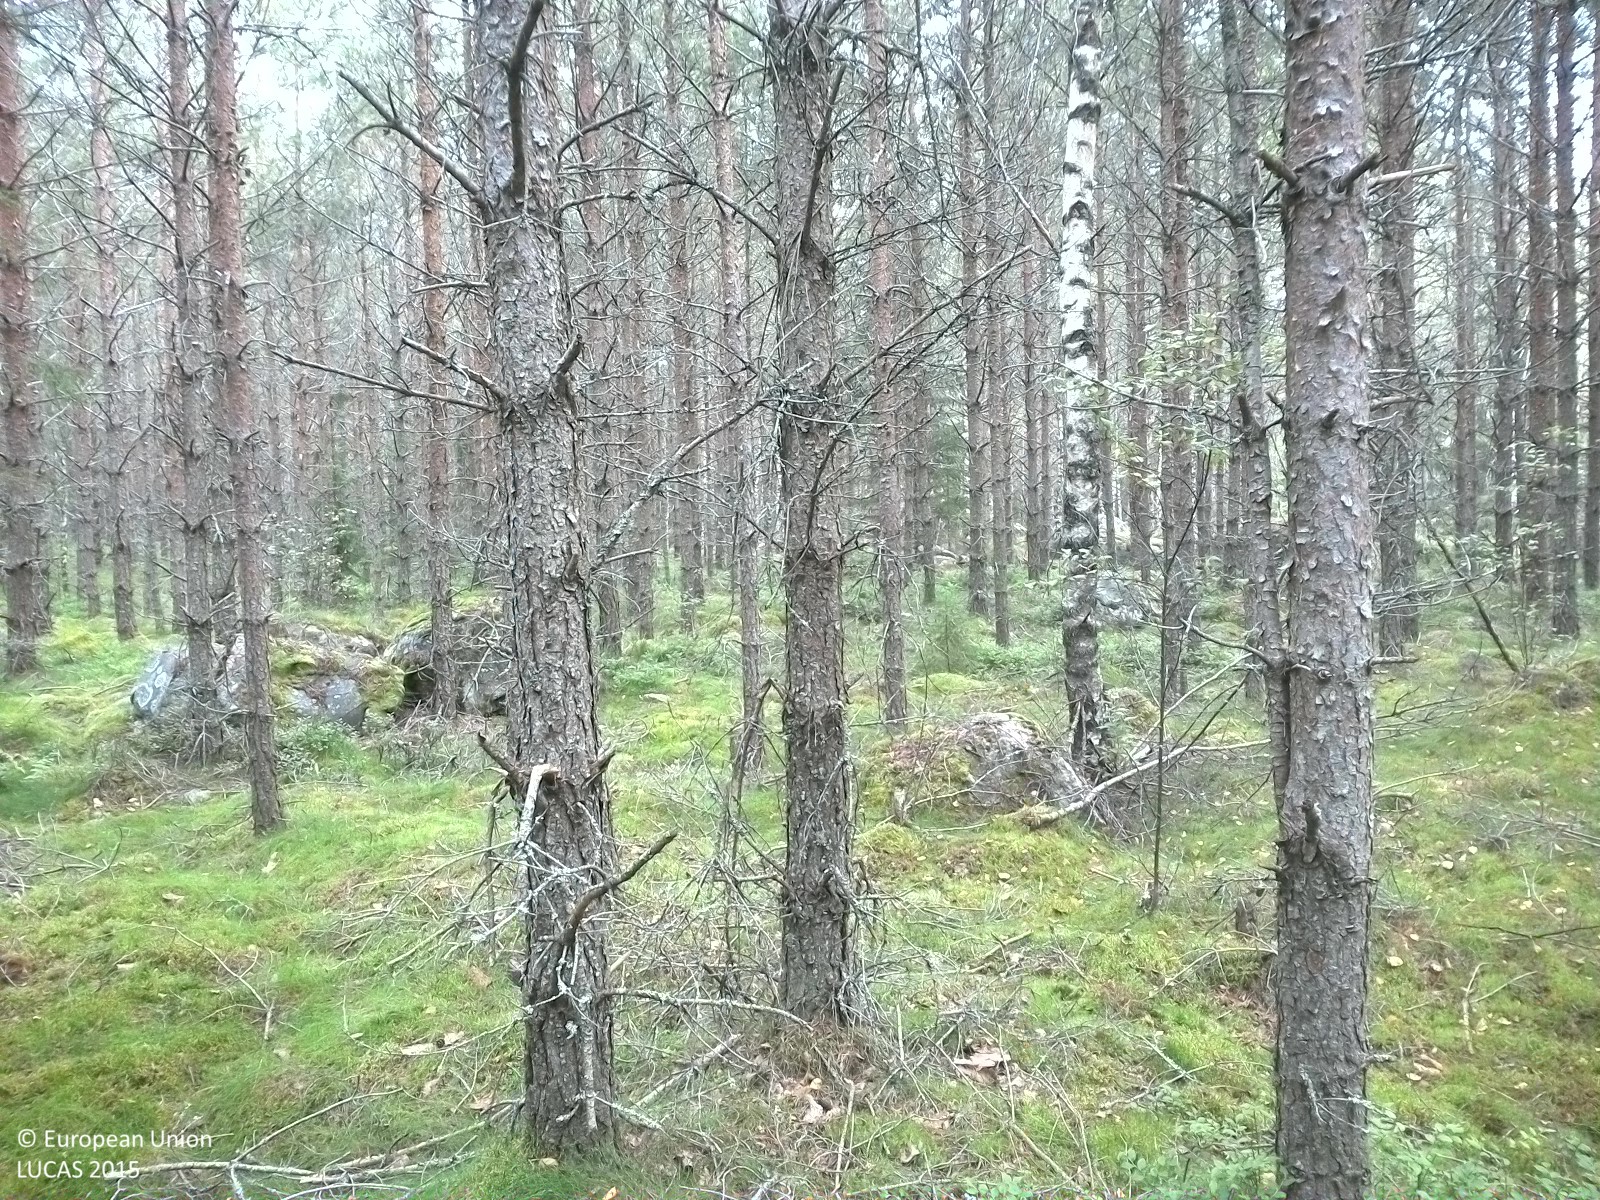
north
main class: Woodland
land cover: Pine dominated coniferous woodland
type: boreal forest
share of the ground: 25 - 50 %
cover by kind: herbaceous plants 45 %, coniferous forest trees 35 %, lichens and mosses 20 %
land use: Forestry
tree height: > 5 m
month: August
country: SE
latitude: 59.1313
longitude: 14.6225
